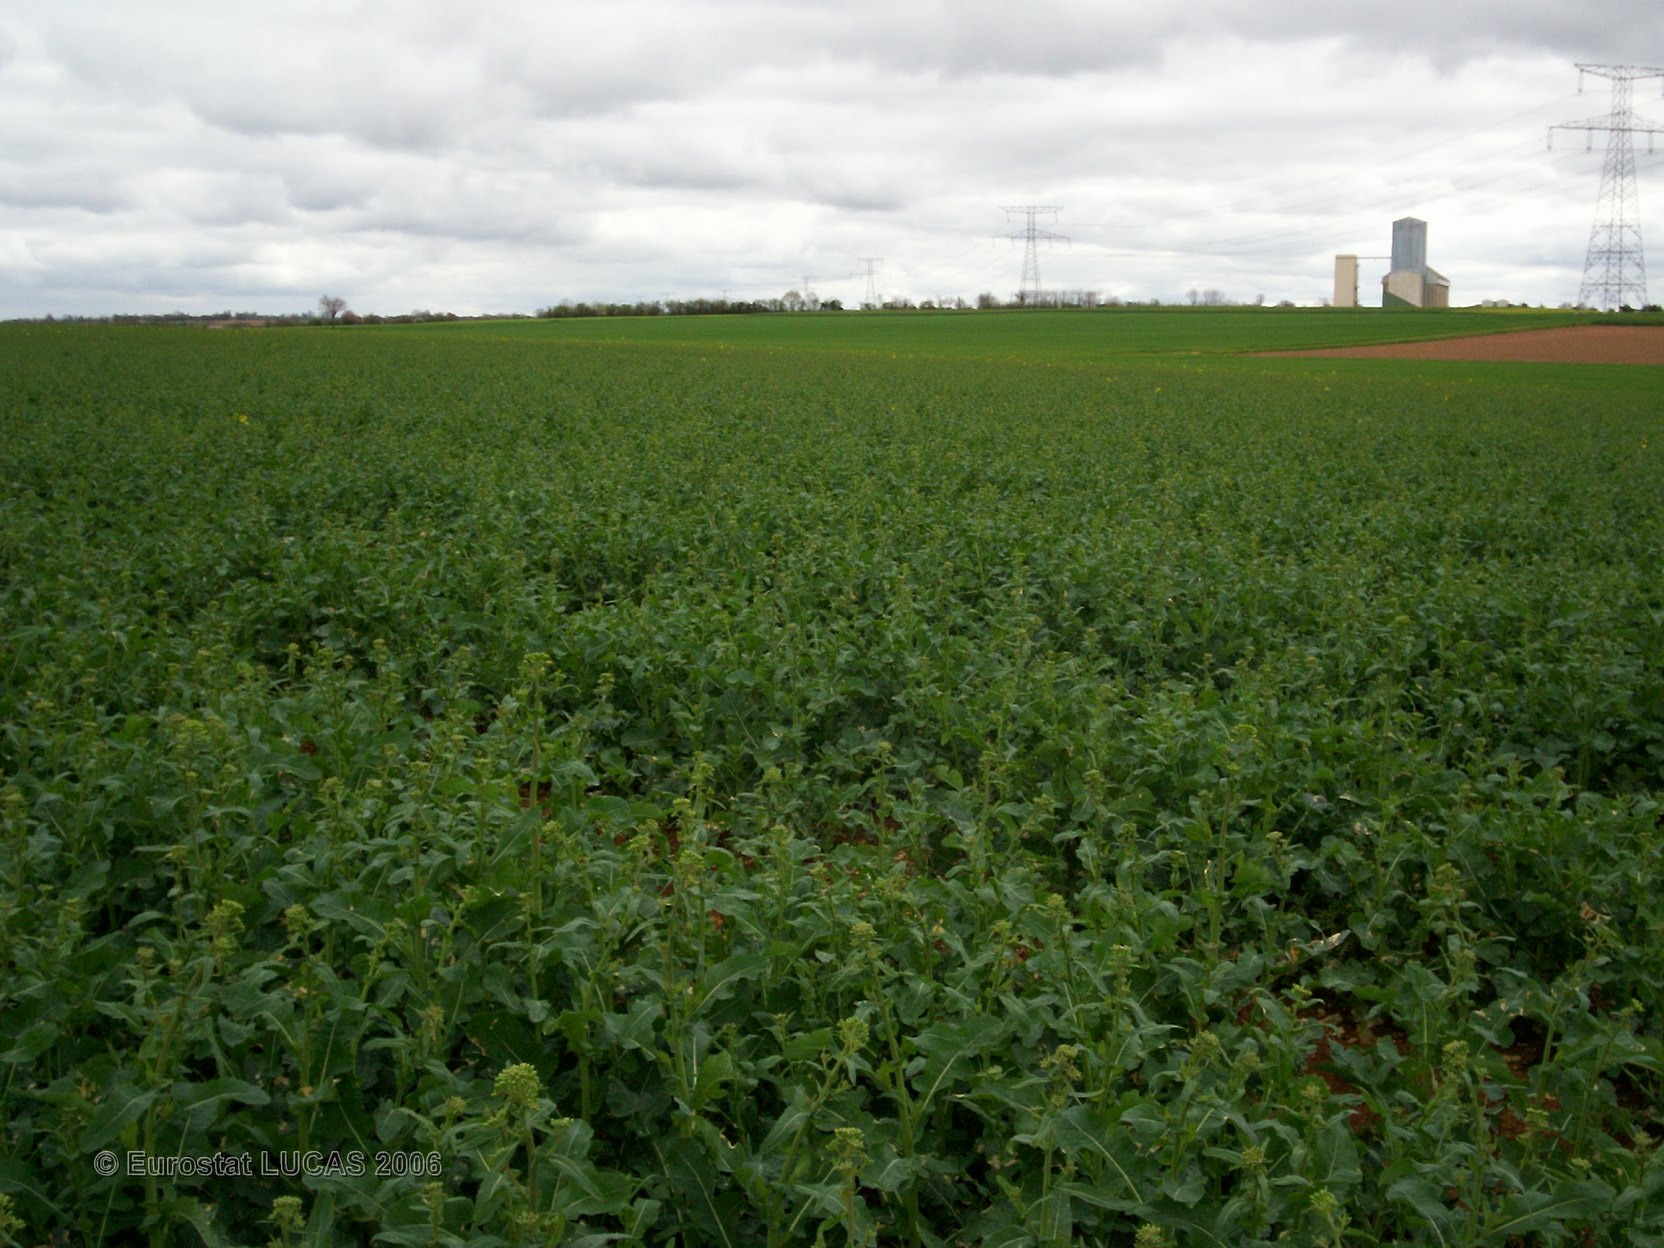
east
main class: Cropland
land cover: Rape and turnip rape
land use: Agriculture (excluding fallow land and kitchen gardens)
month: April
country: FR
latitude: 46.2738
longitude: -0.2616
